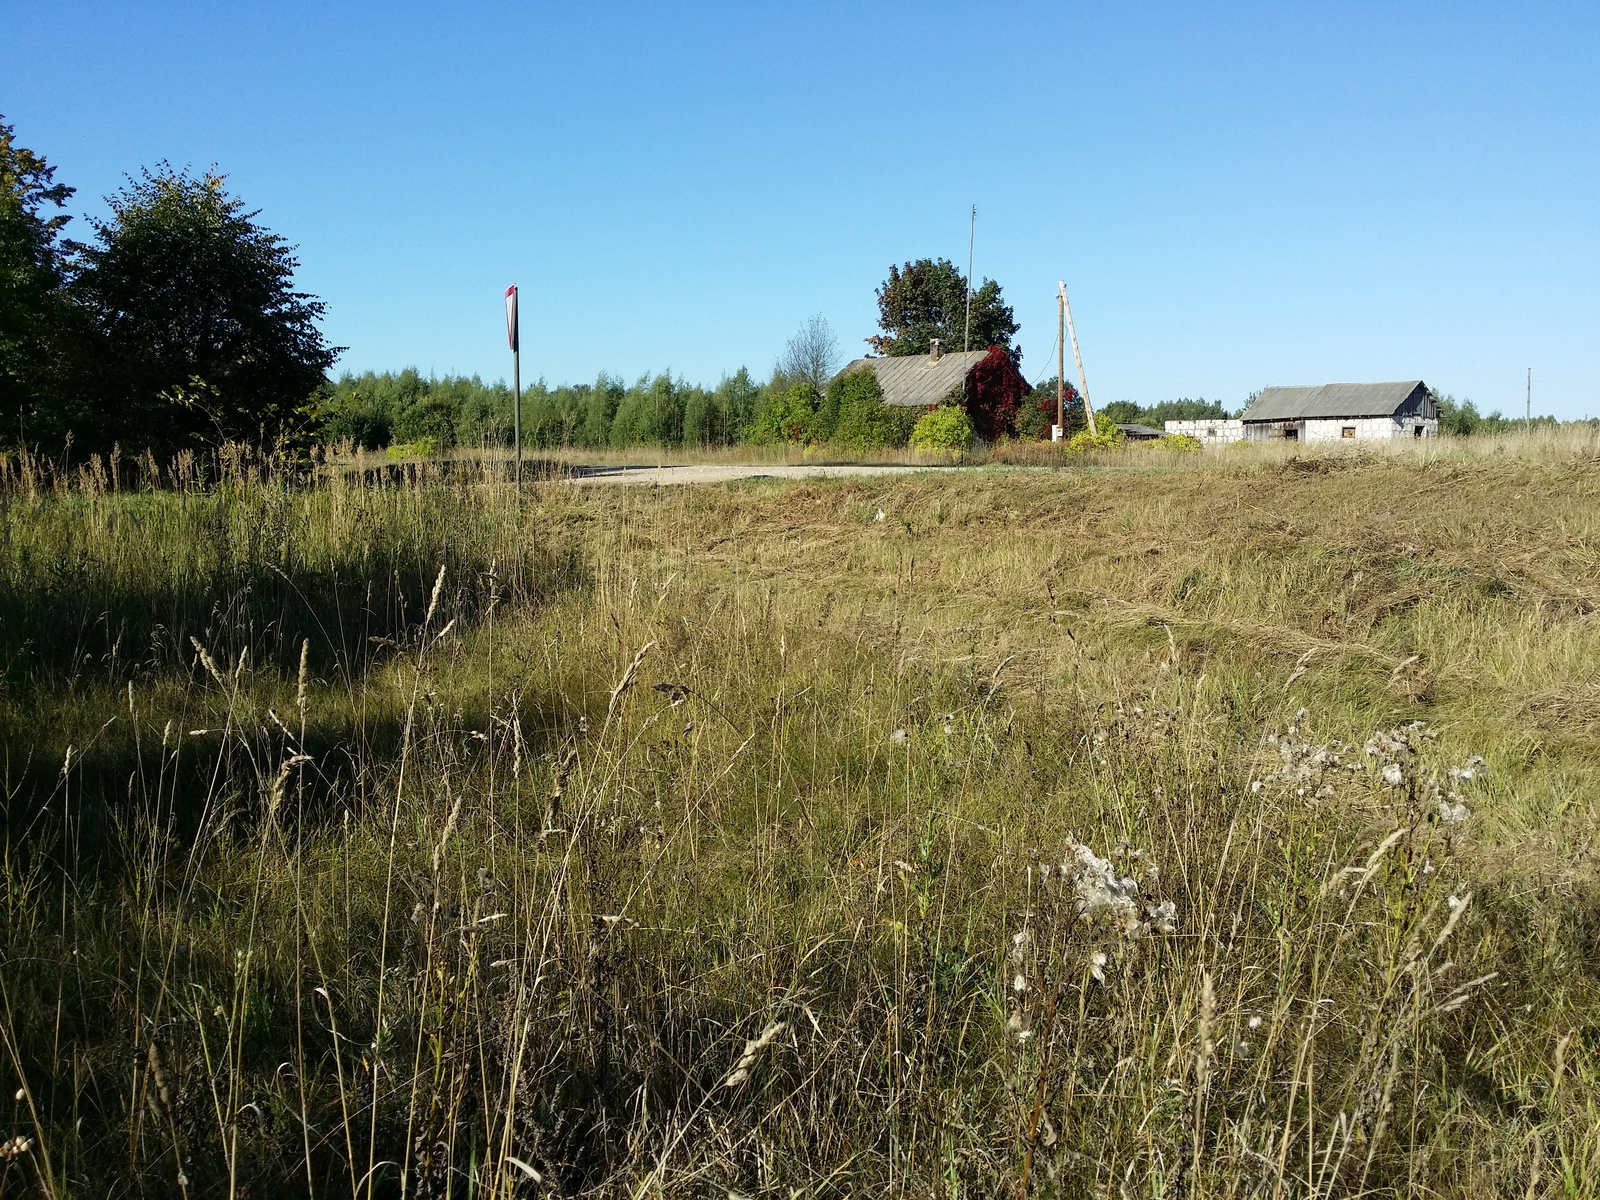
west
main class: Grassland
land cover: Grassland without tree/shrub cover
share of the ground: > 75 %
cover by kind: herbaceous plants 100 %
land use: Agriculture (excluding fallow land and kitchen gardens)
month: September
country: LV
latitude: 57.1731
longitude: 27.5952
